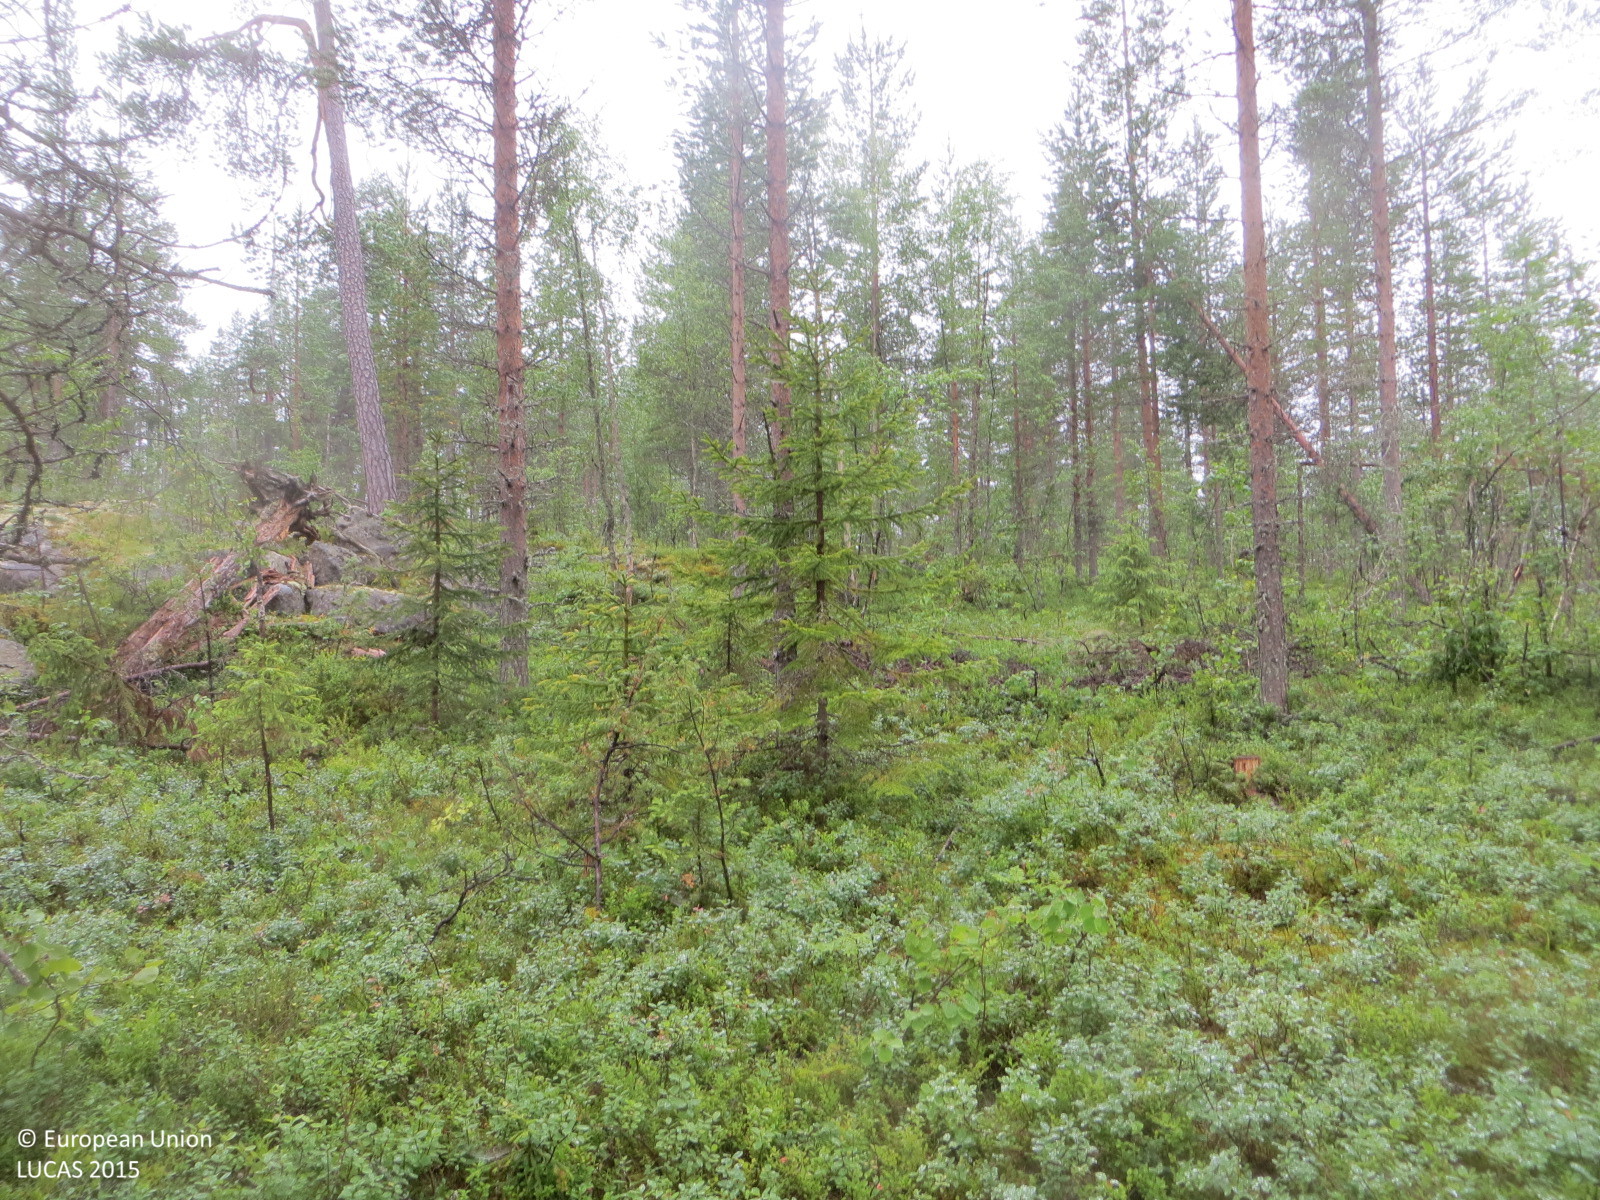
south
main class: Woodland
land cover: Pine dominated coniferous woodland
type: boreal forest
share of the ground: 50 - 75 %
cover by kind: coniferous forest trees 50 %, shrubs 50 %
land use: Forestry
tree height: > 5 m
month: August
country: FI
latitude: 66.0713
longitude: 25.5145
